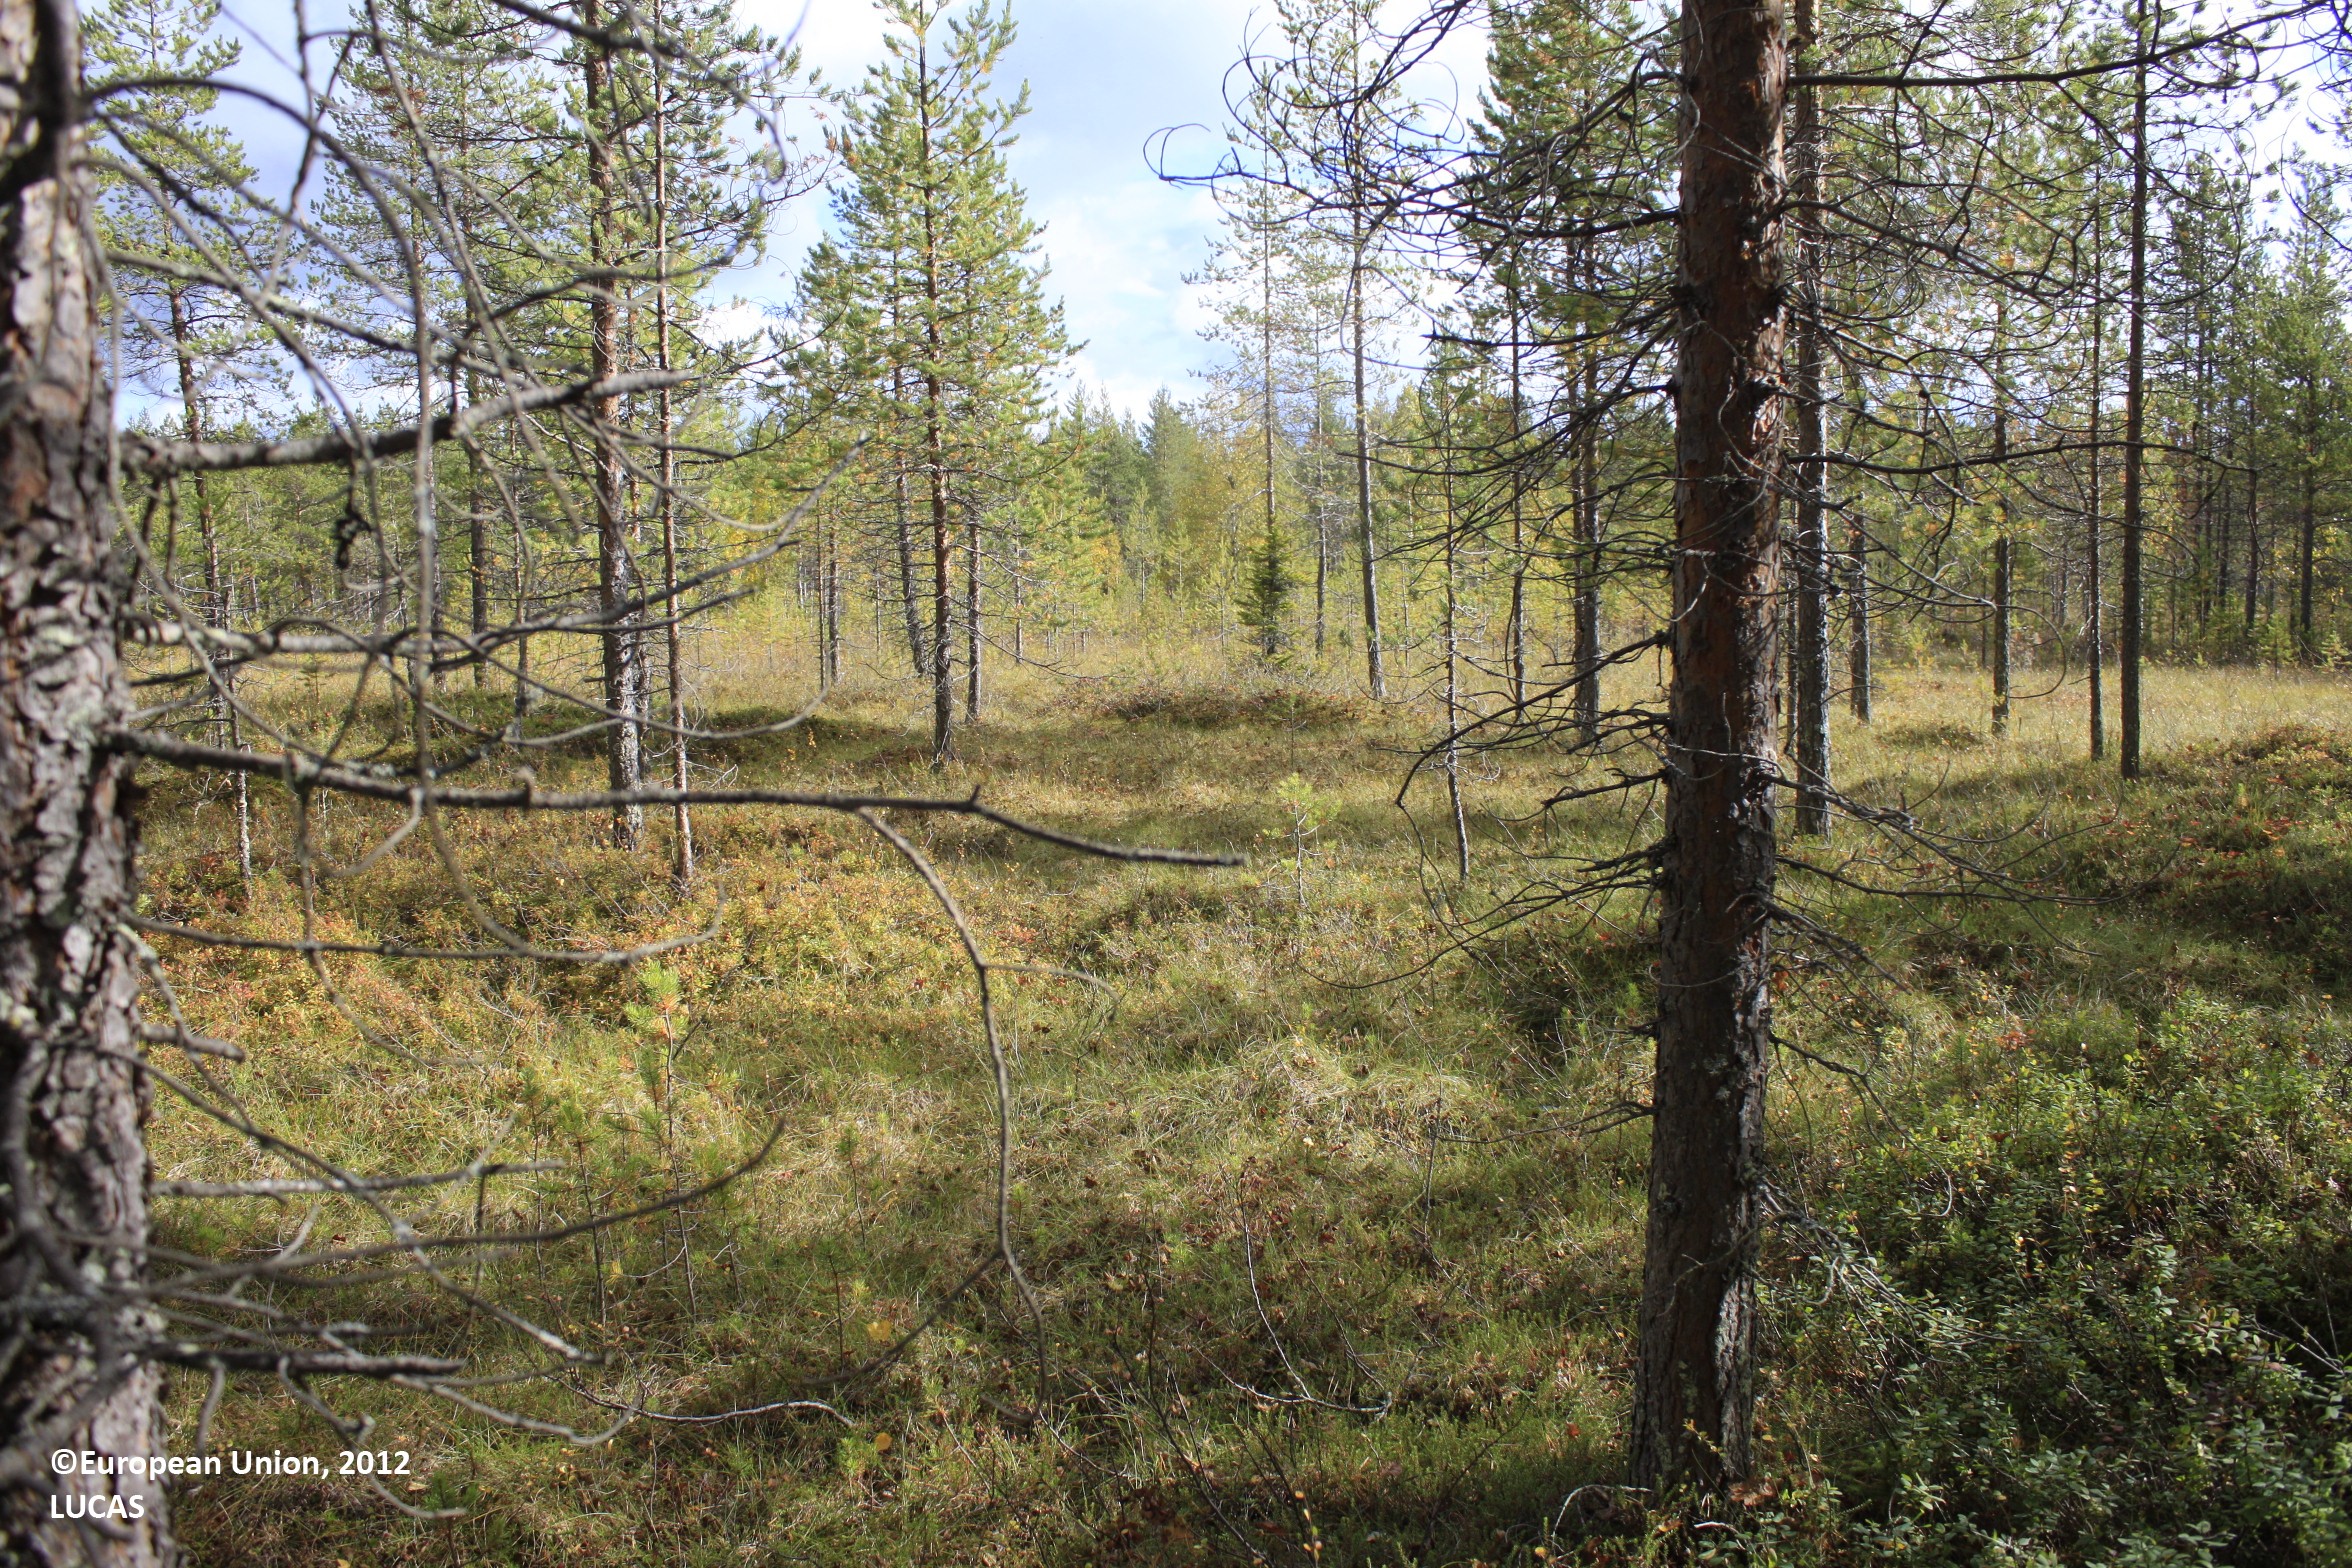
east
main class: Woodland
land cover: Pine dominated mixed woodland
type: mire and swamp forests
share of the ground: 25 - 50 %
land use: Forestry
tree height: > 5 m
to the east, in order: Pine dominated mixed woodland; Peatbogs; Ditches and canals; Pine dominated mixed woodland; Ditches and canals; Pine dominated coniferous woodland
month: September
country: FI
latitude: 65.6713
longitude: 26.5684
